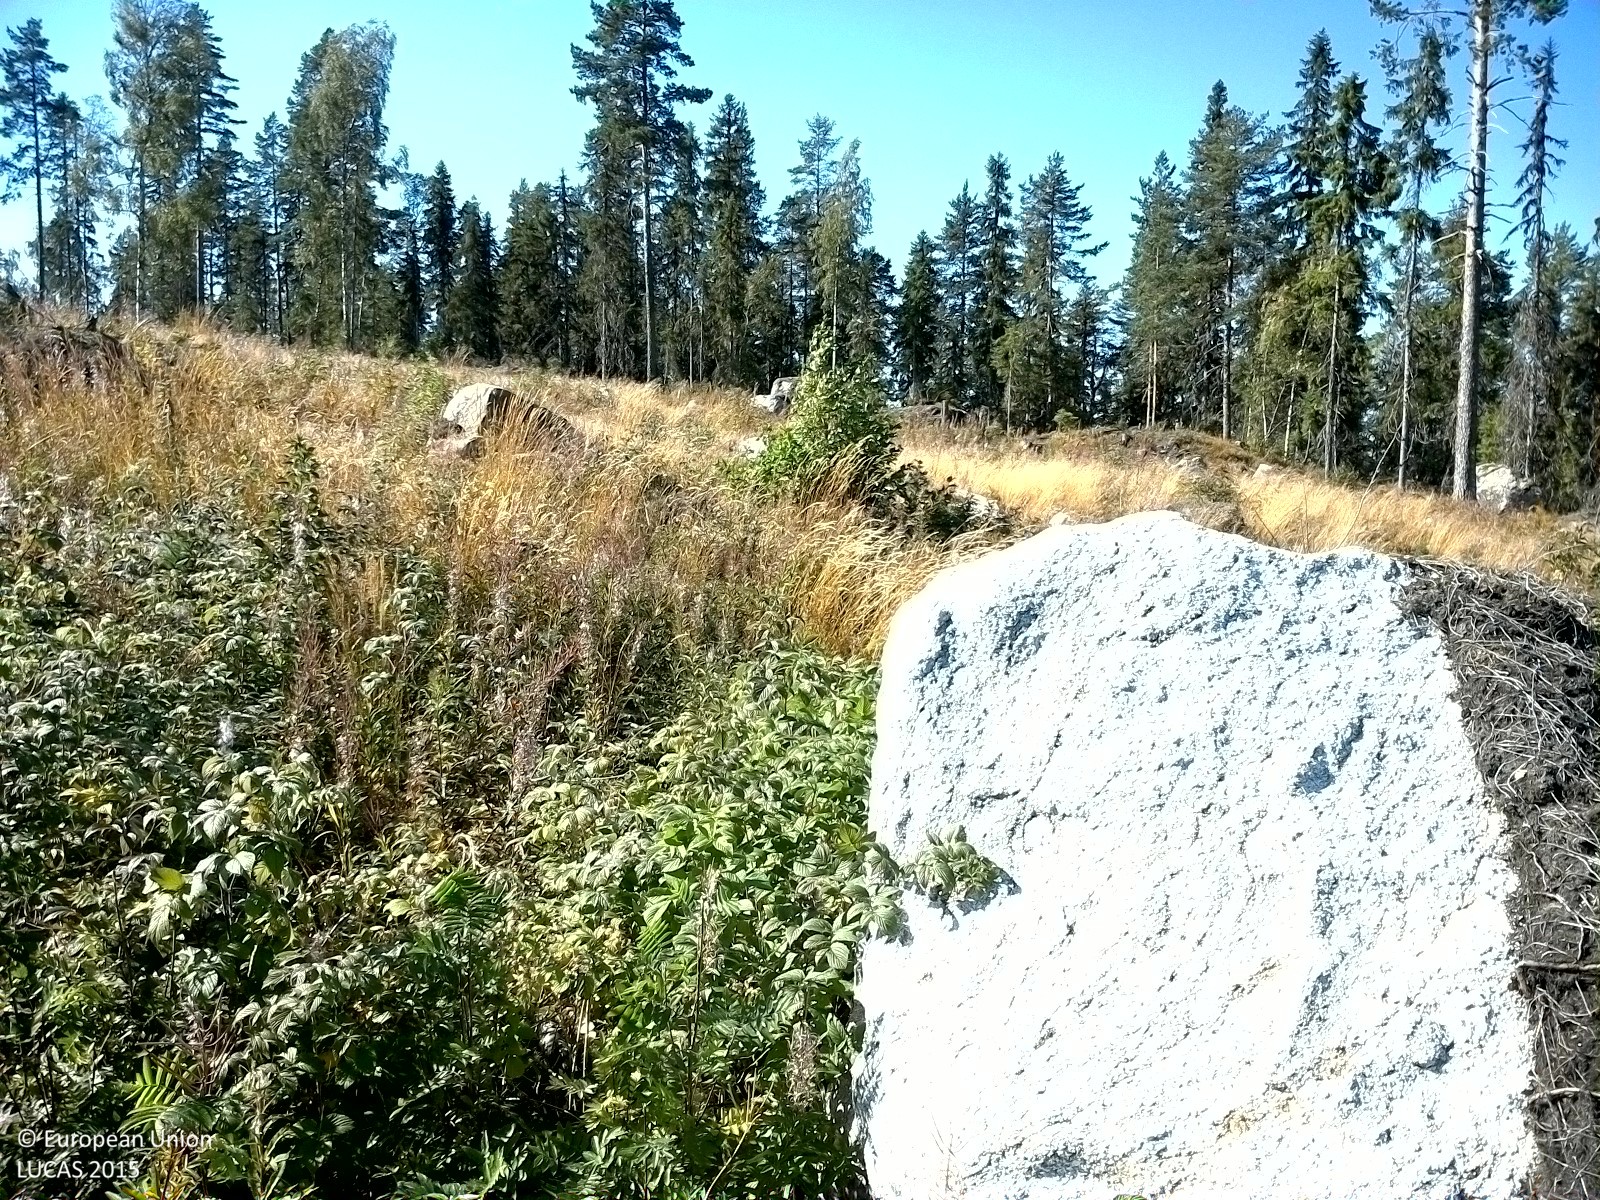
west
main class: Woodland
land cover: Spruce dominated mixed woodland
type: boreal forest
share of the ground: 10 - 25 %
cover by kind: herbaceous plants 55 %, shrubs 35 %, coniferous forest trees 5 %, broadleaved forest trees 5 %
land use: Forestry
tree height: < 5 m
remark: Clear cut
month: August
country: SE
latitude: 62.3663
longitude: 16.8408
